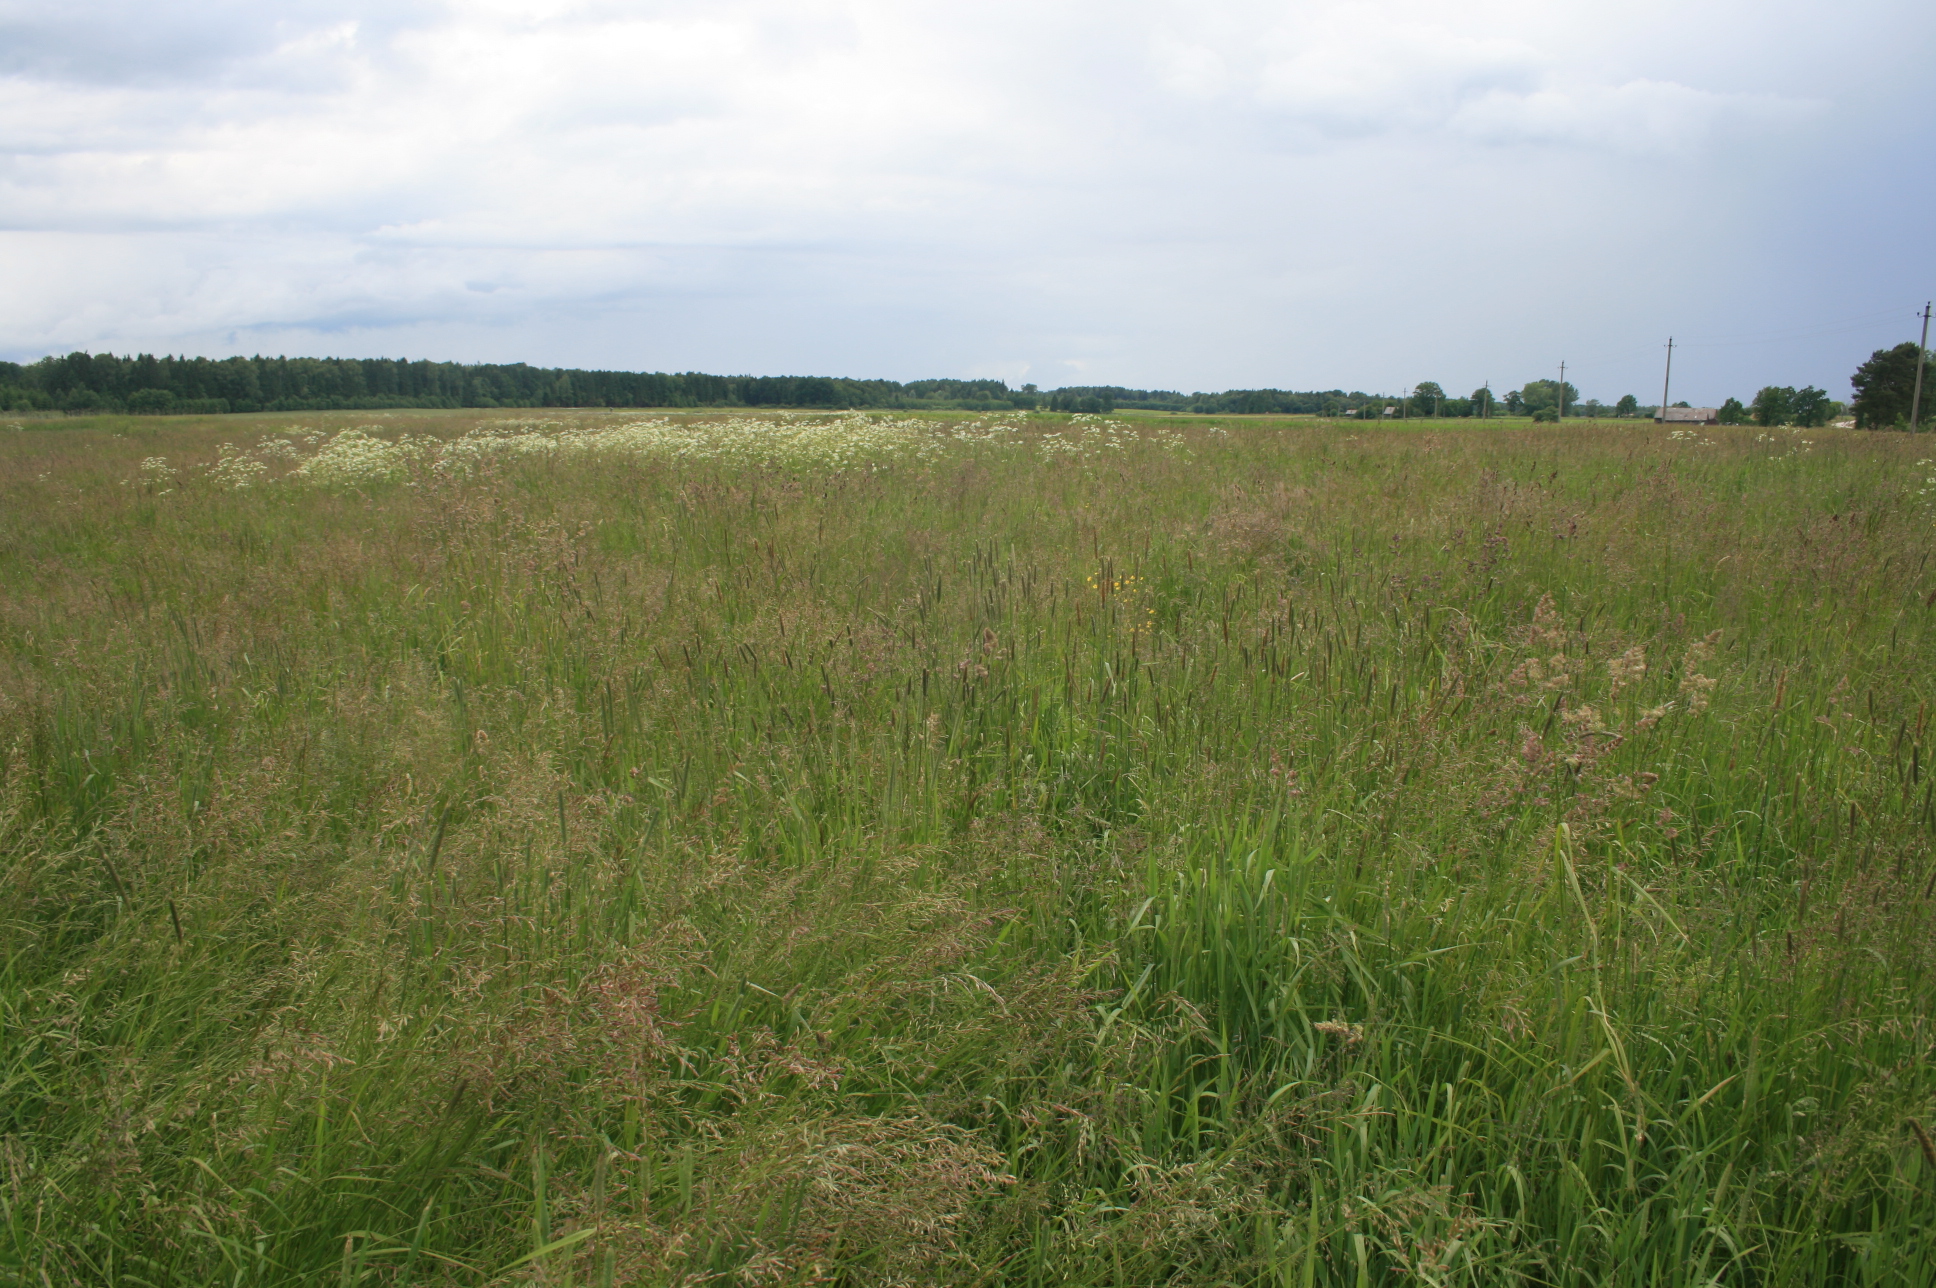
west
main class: Grassland
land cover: Grassland without tree/shrub cover
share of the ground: > 75 %
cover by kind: herbaceous plants 100 %
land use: Agriculture (excluding fallow land and kitchen gardens)
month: June
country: LT
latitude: 55.4258
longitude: 22.3359
